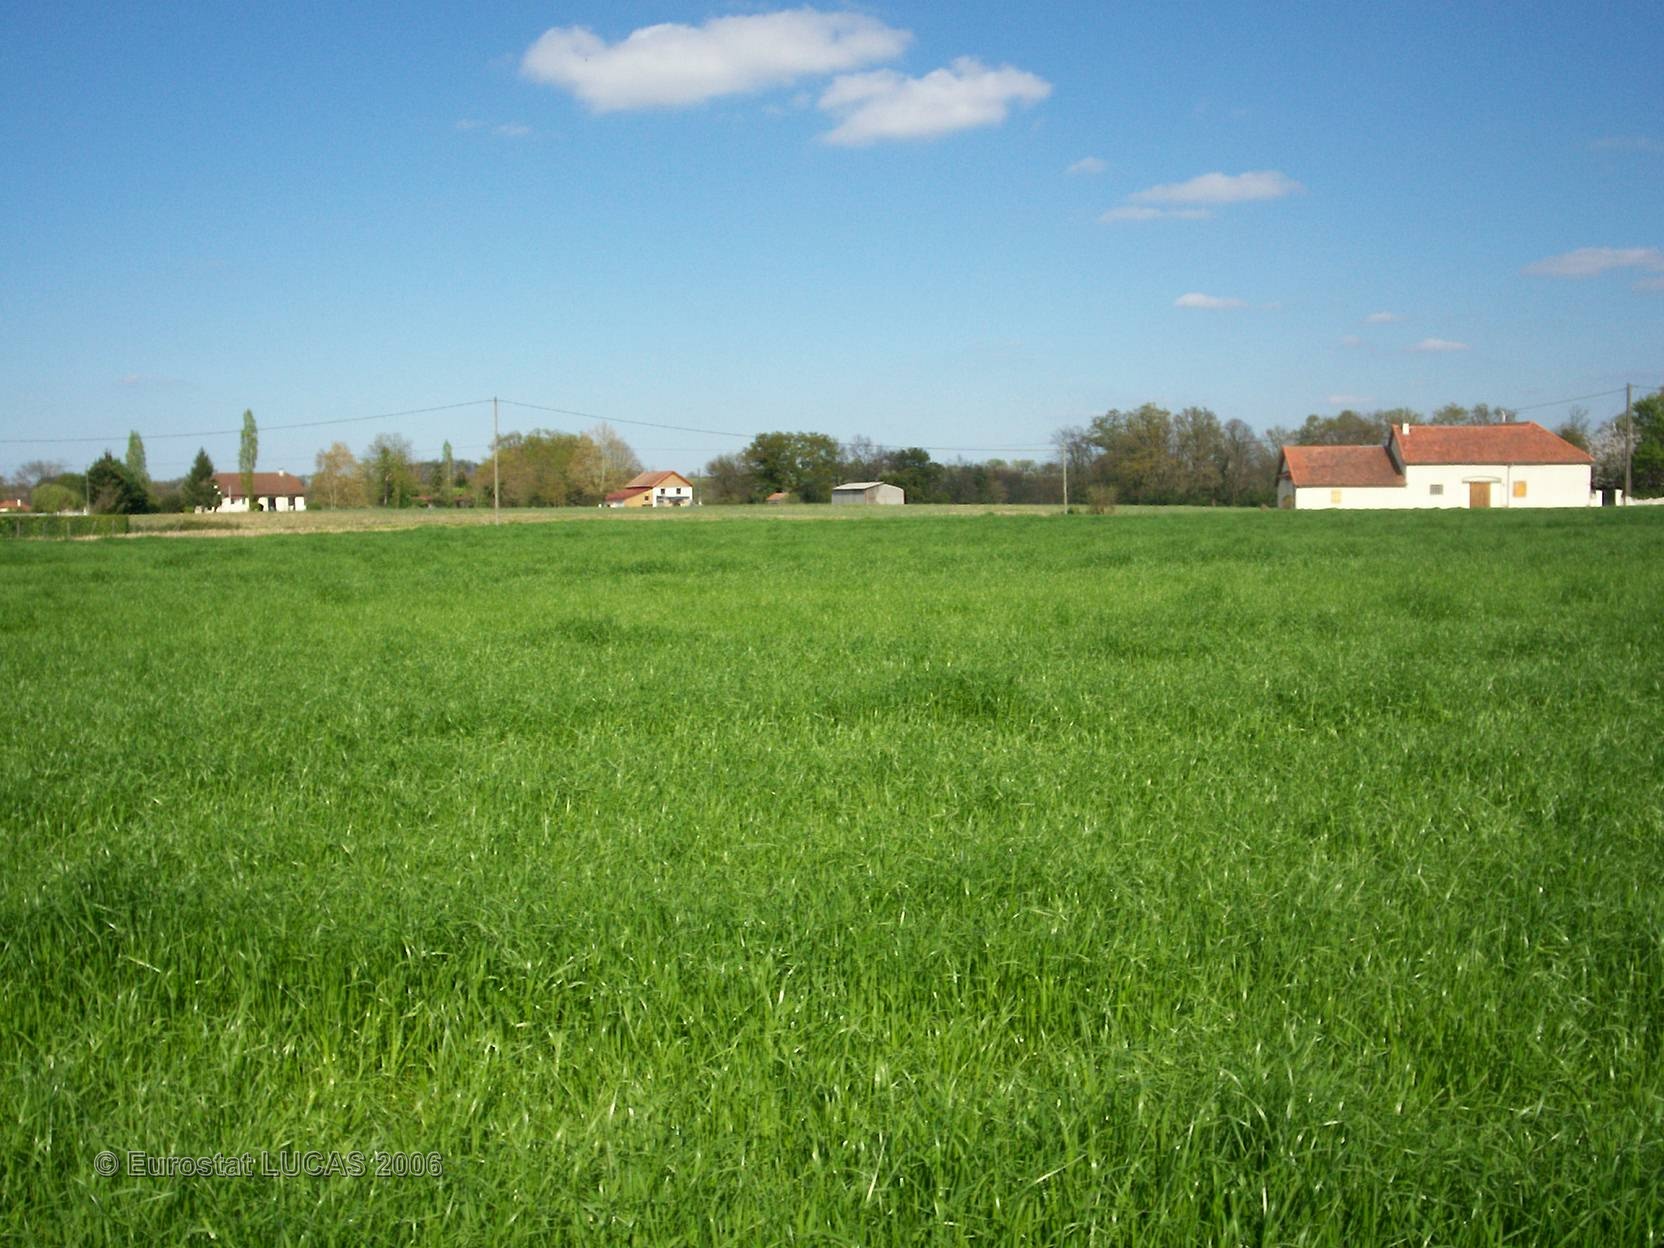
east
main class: Cropland
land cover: Other leguminous and mixtures for fodder
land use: Agriculture (excluding fallow land and kitchen gardens)
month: April
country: FR
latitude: 43.4345
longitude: -0.3230
